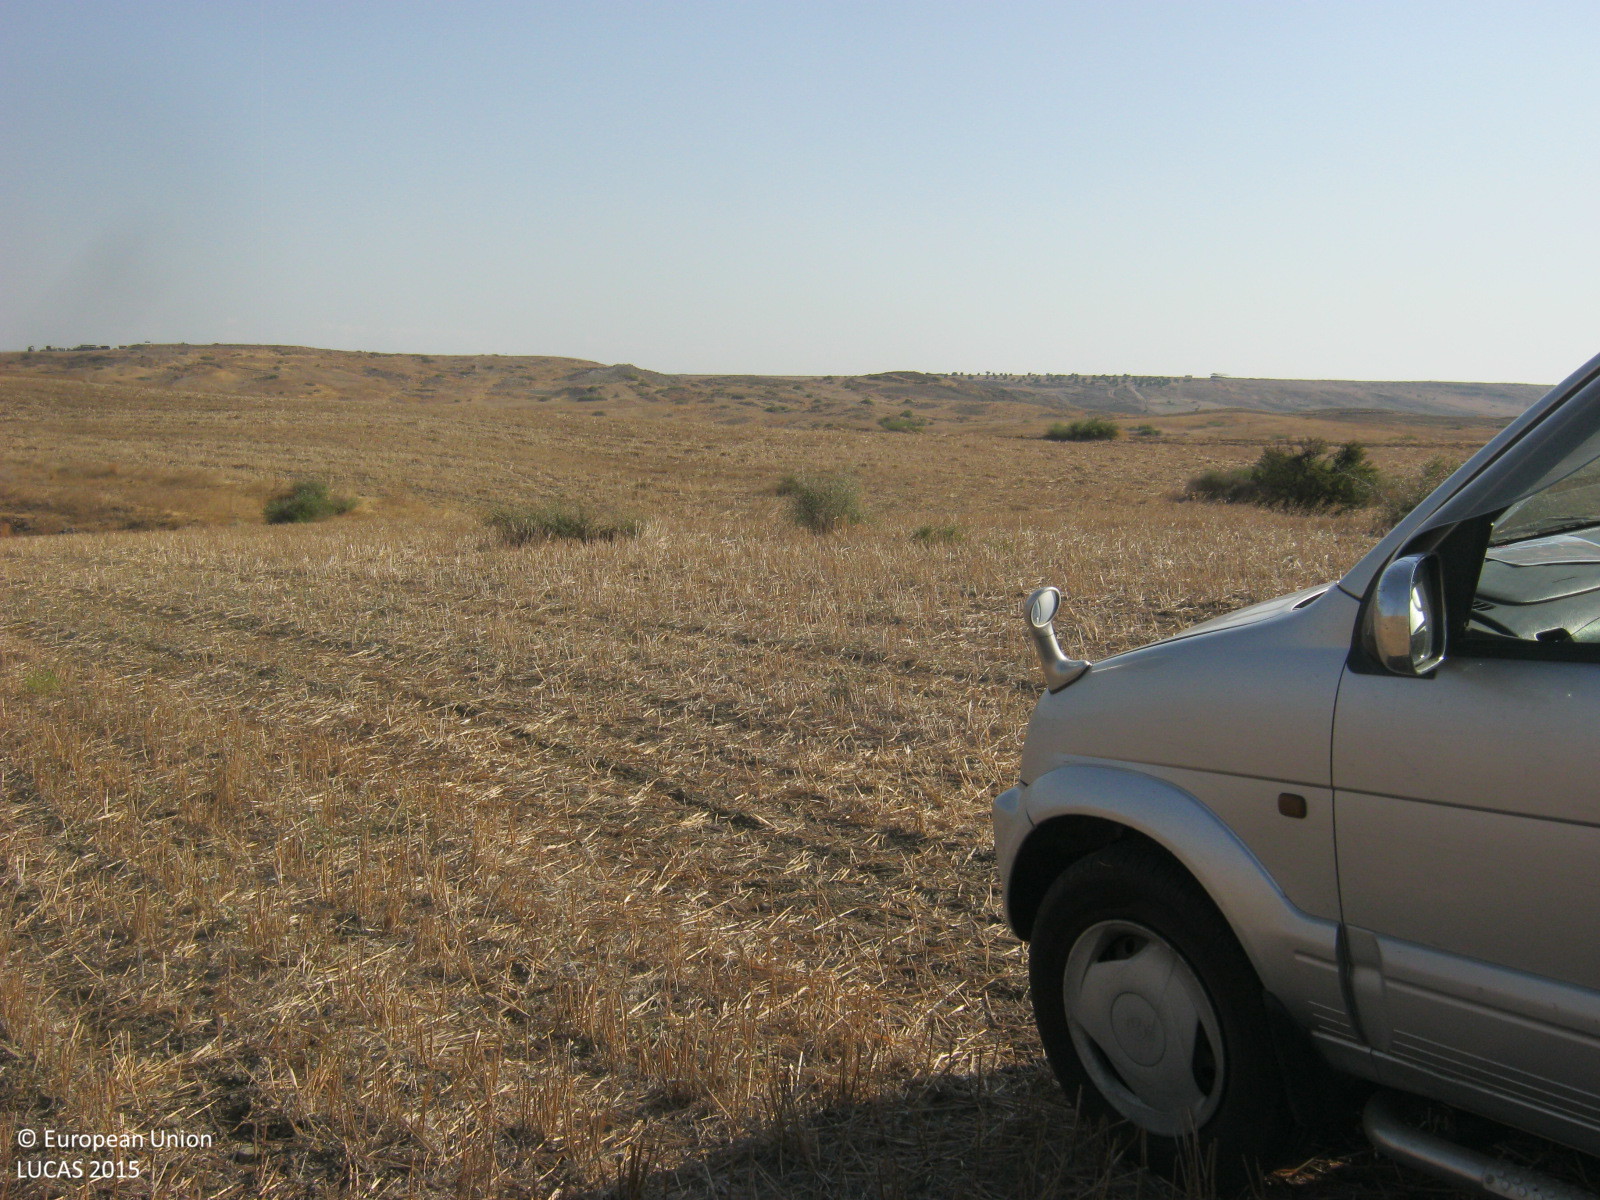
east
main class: Cropland
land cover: Mixed cereals for fodder
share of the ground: < 10 %
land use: Agriculture (excluding fallow land and kitchen gardens)
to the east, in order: Mixed cereals for fodder; Rivers and streams; Mixed cereals for fodder; Tracks; Mixed cereals for fodder; Tracks; Mixed cereals for fodder; Other bare soil
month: September
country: CY
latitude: 35.0822
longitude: 33.0462
